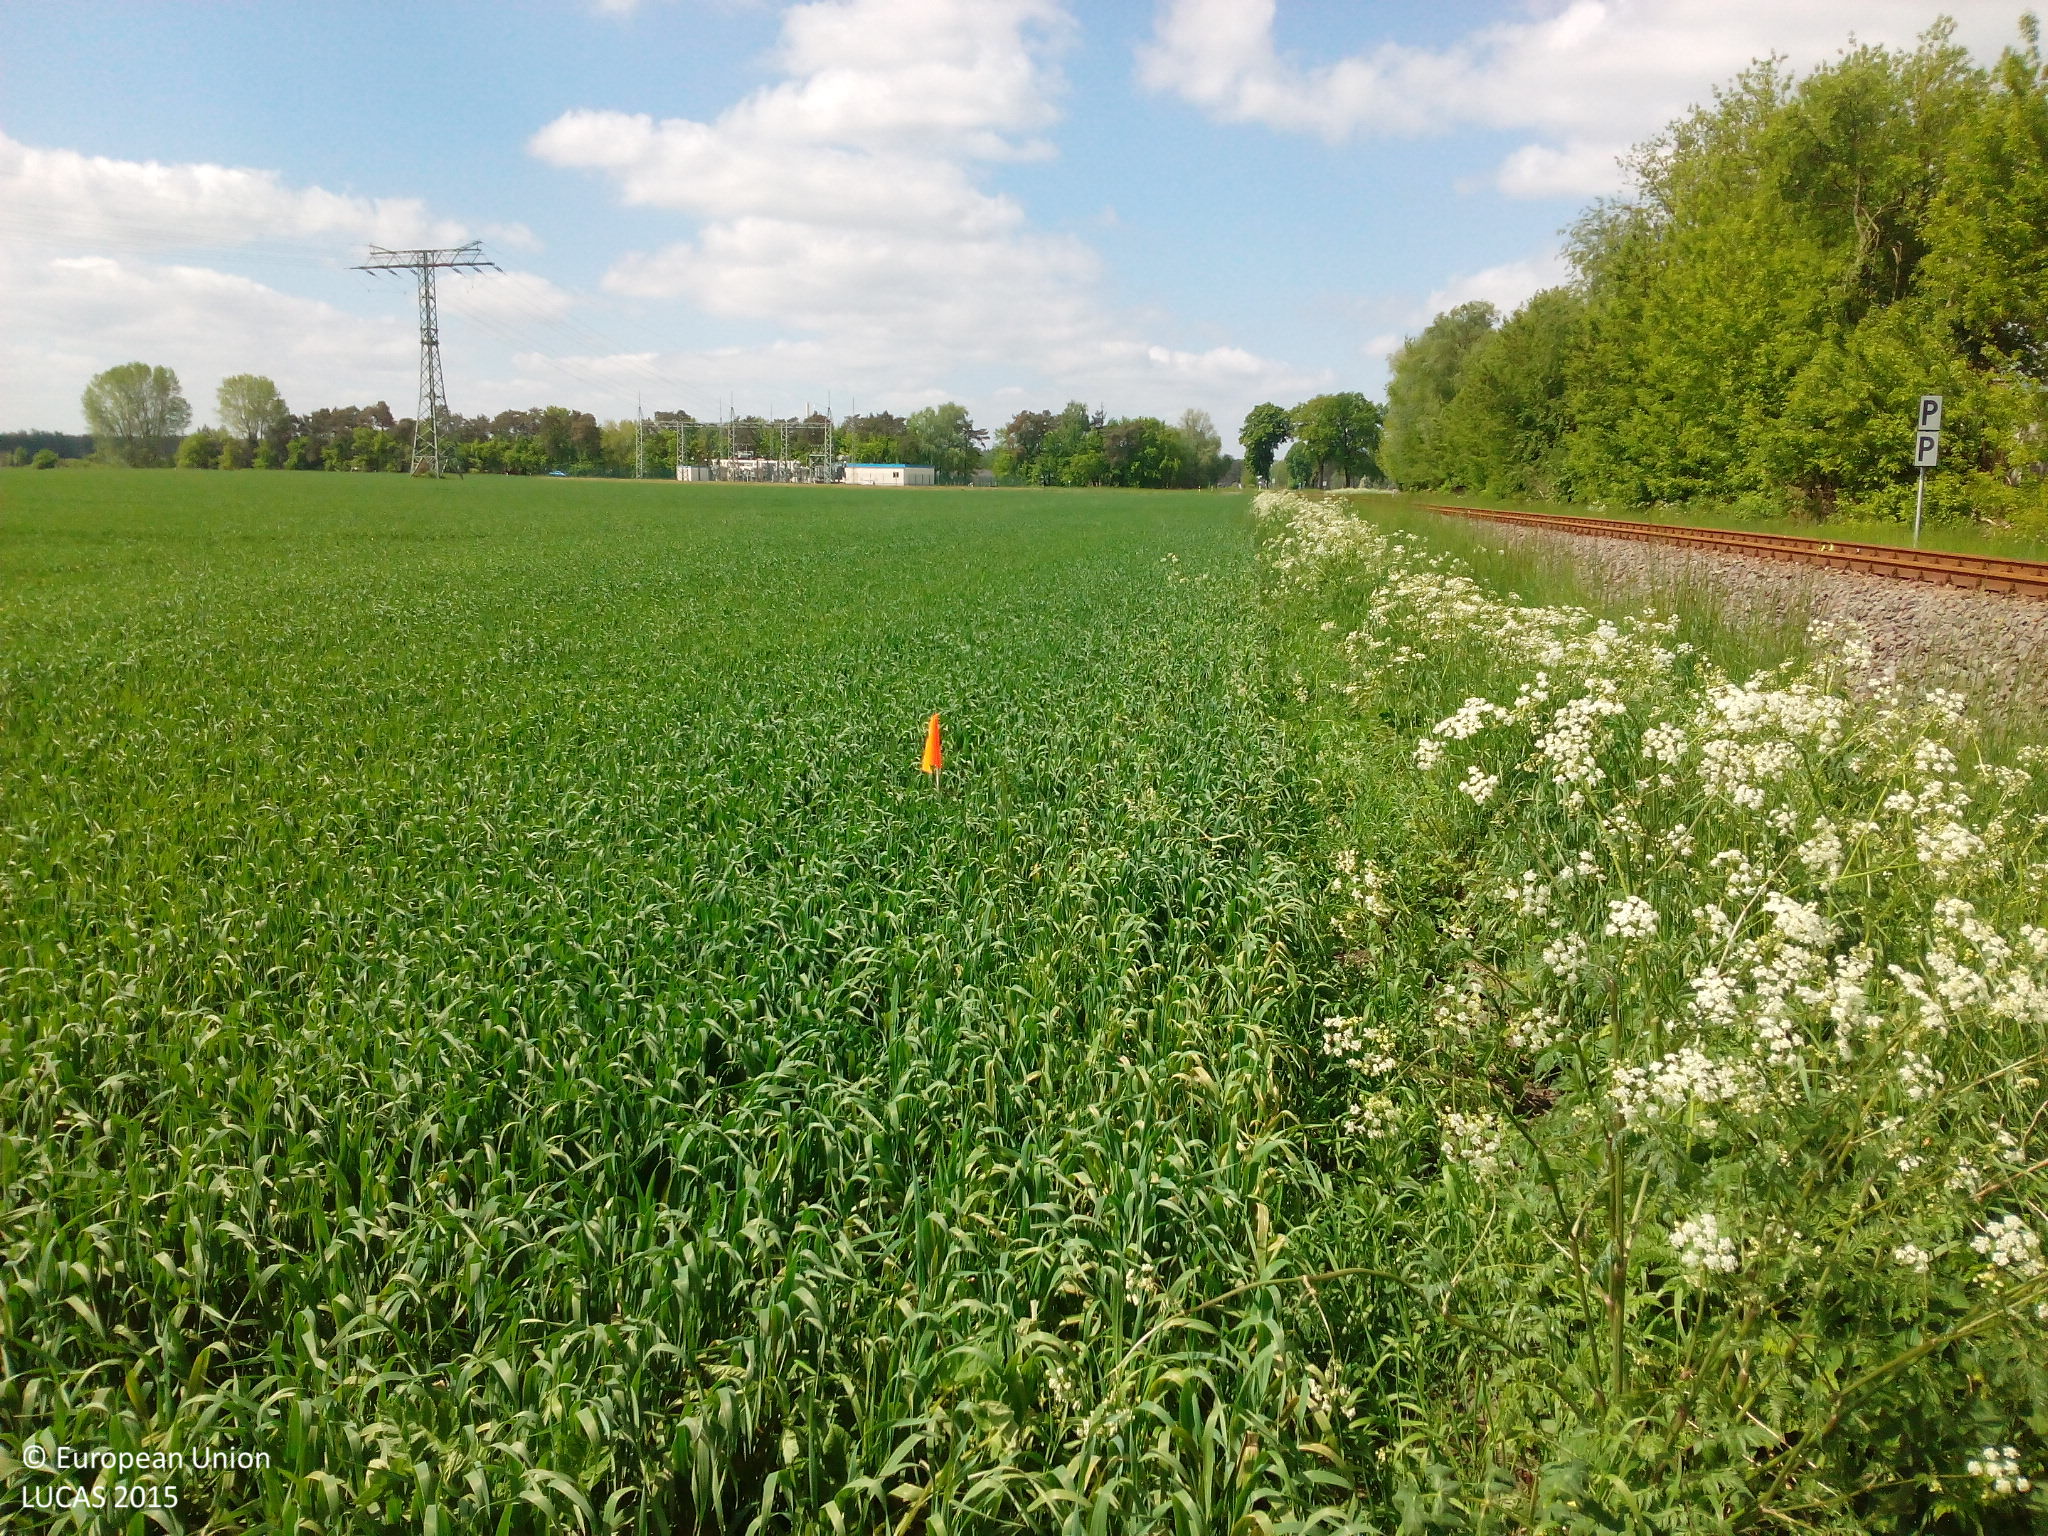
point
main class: Cropland
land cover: Oats
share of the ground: > 75 %
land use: Agriculture (excluding fallow land and kitchen gardens)
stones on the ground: < 10 %
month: May
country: DE
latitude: 53.3909
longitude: 11.6384
